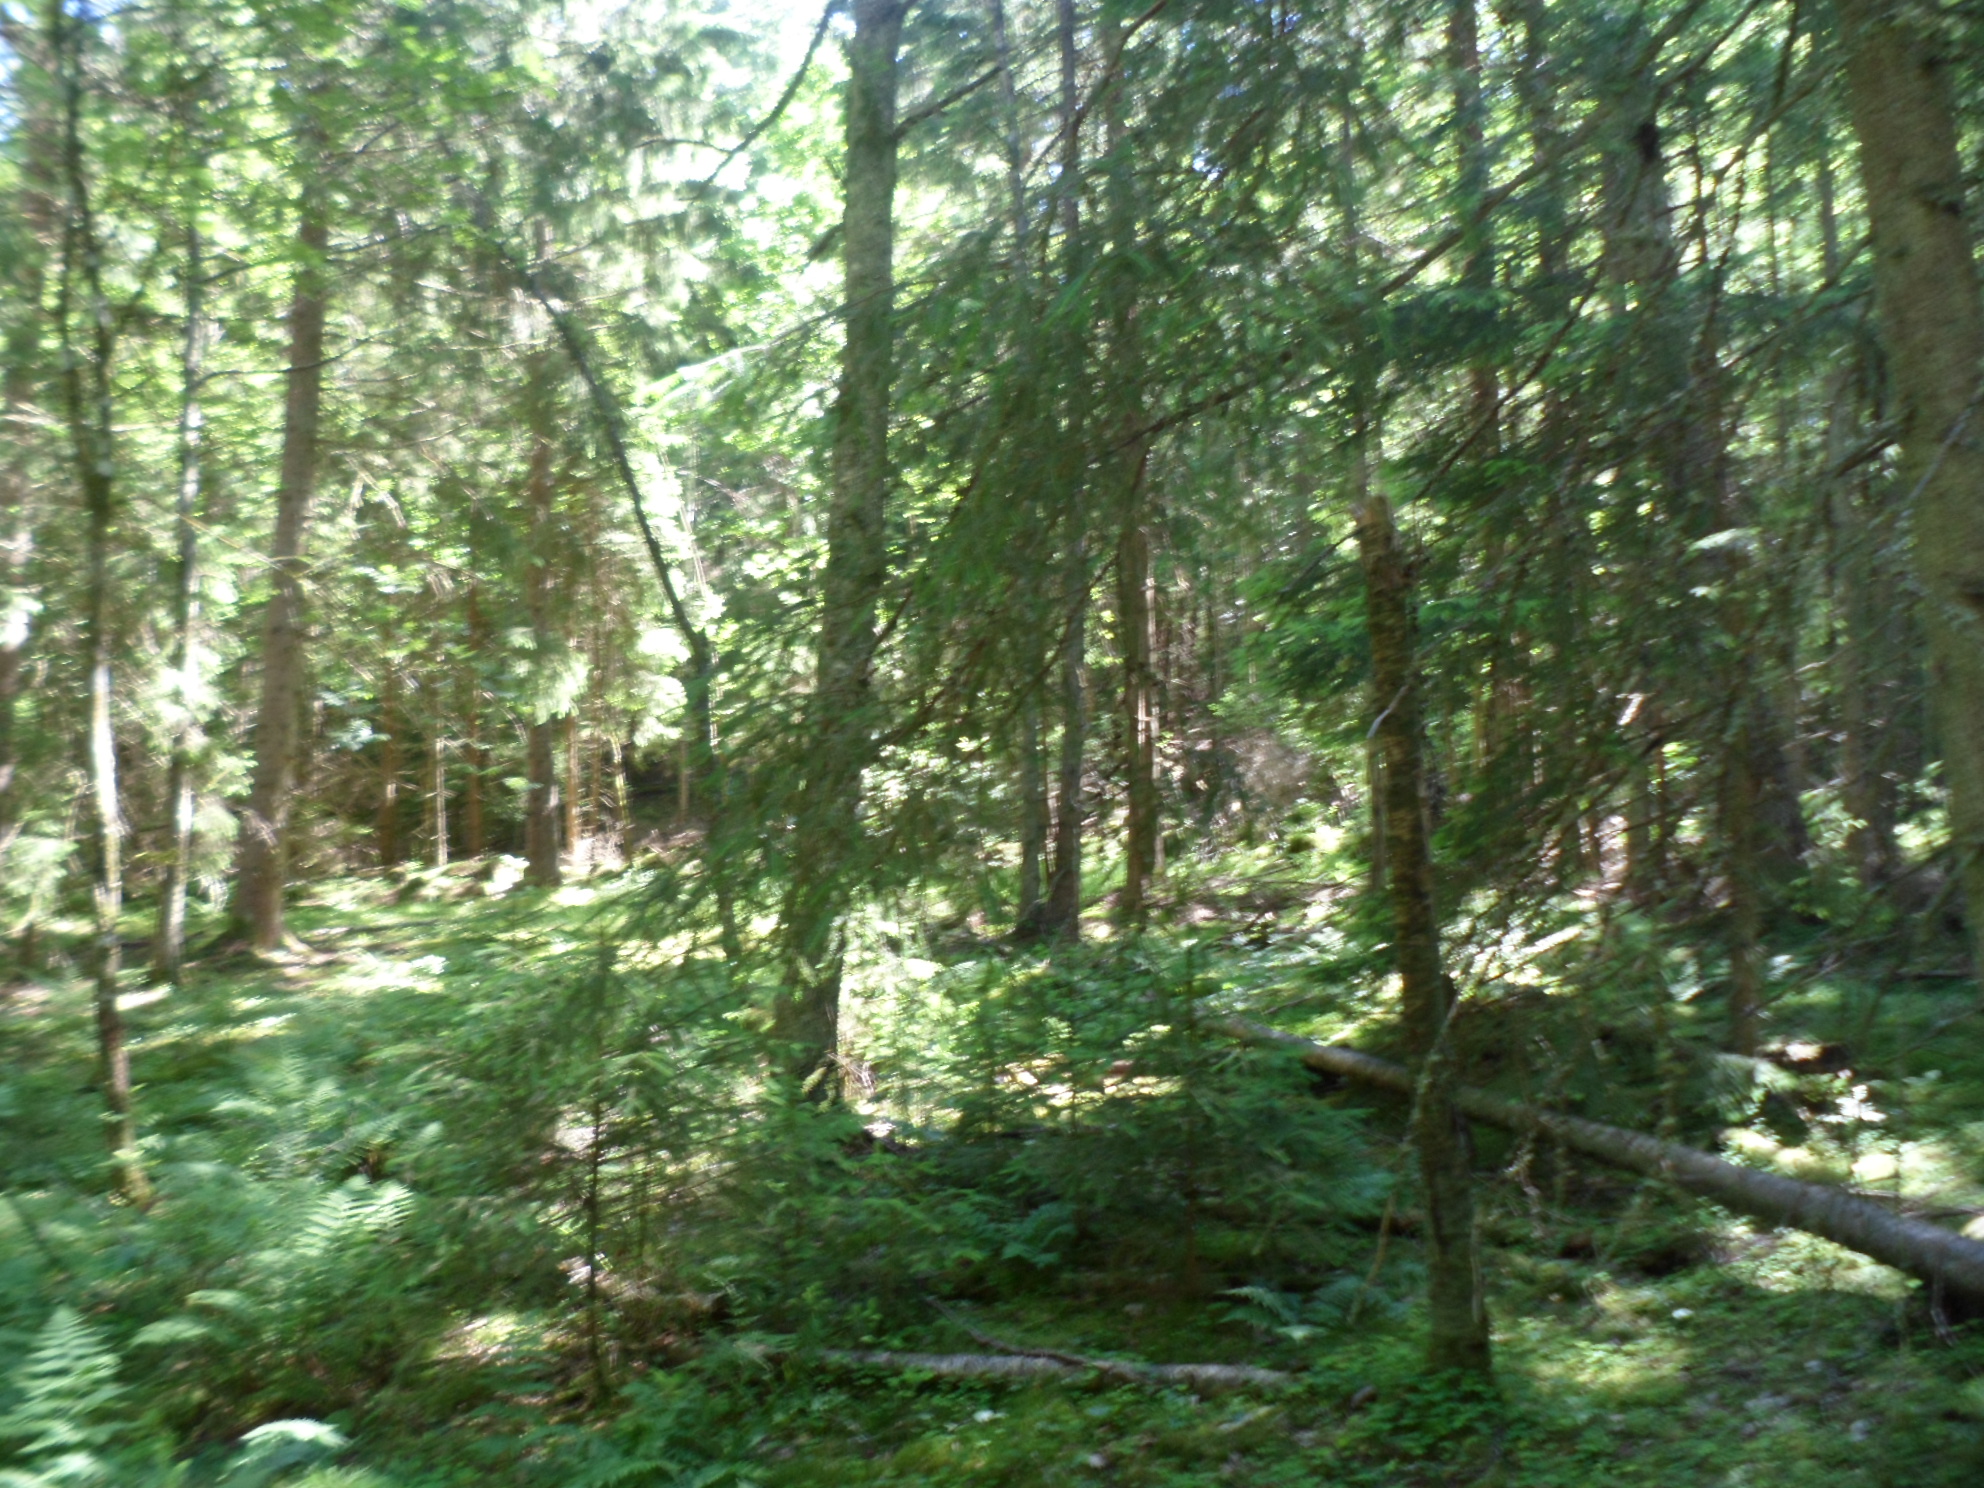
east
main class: Woodland
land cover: Spruce dominated mixed woodland
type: boreal forest
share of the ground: 50 - 75 %
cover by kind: coniferous forest trees 45 %, broadleaved forest trees 30 %, herbaceous plants 10 %, lichens and mosses 10 %, shrubs 5 %
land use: Forestry
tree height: > 5 m
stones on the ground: < 10 %
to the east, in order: Spruce dominated mixed woodland; Fences; Tracks; Spruce dominated coniferous woodland; Dry stone walls; Spruce dominated coniferous woodland; Spruce dominated mixed woodland; Grassland without tree/shrub cover; Paved roads, cycling and walking lanes
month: July
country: SE
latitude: 57.0814
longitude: 14.5006
